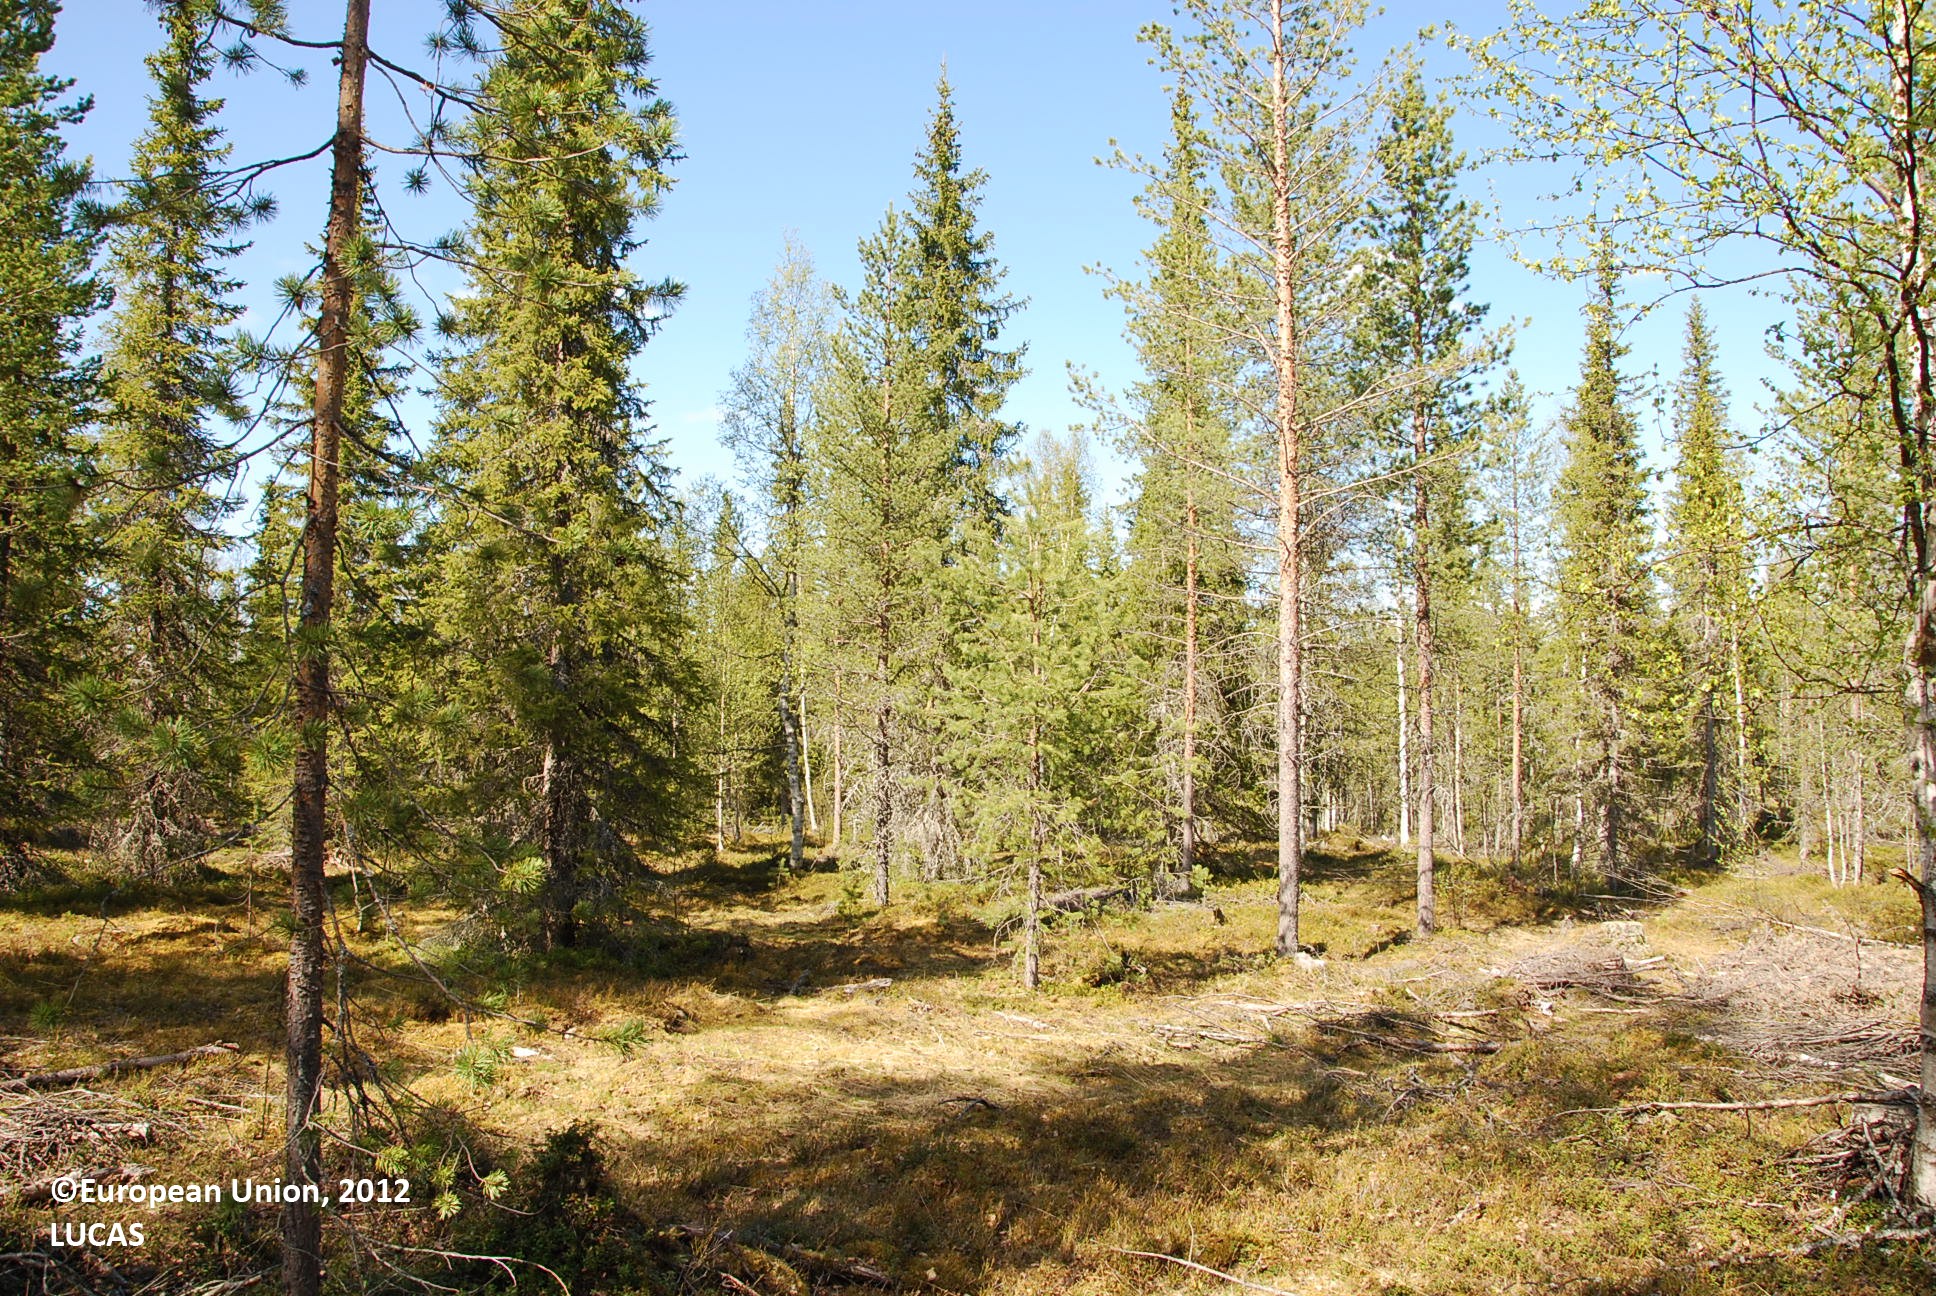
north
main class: Woodland
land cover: Spruce dominated mixed woodland
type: boreal forest
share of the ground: 50 - 75 %
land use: Forestry
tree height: > 5 m
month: June
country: FI
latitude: 66.9655
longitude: 28.2925
